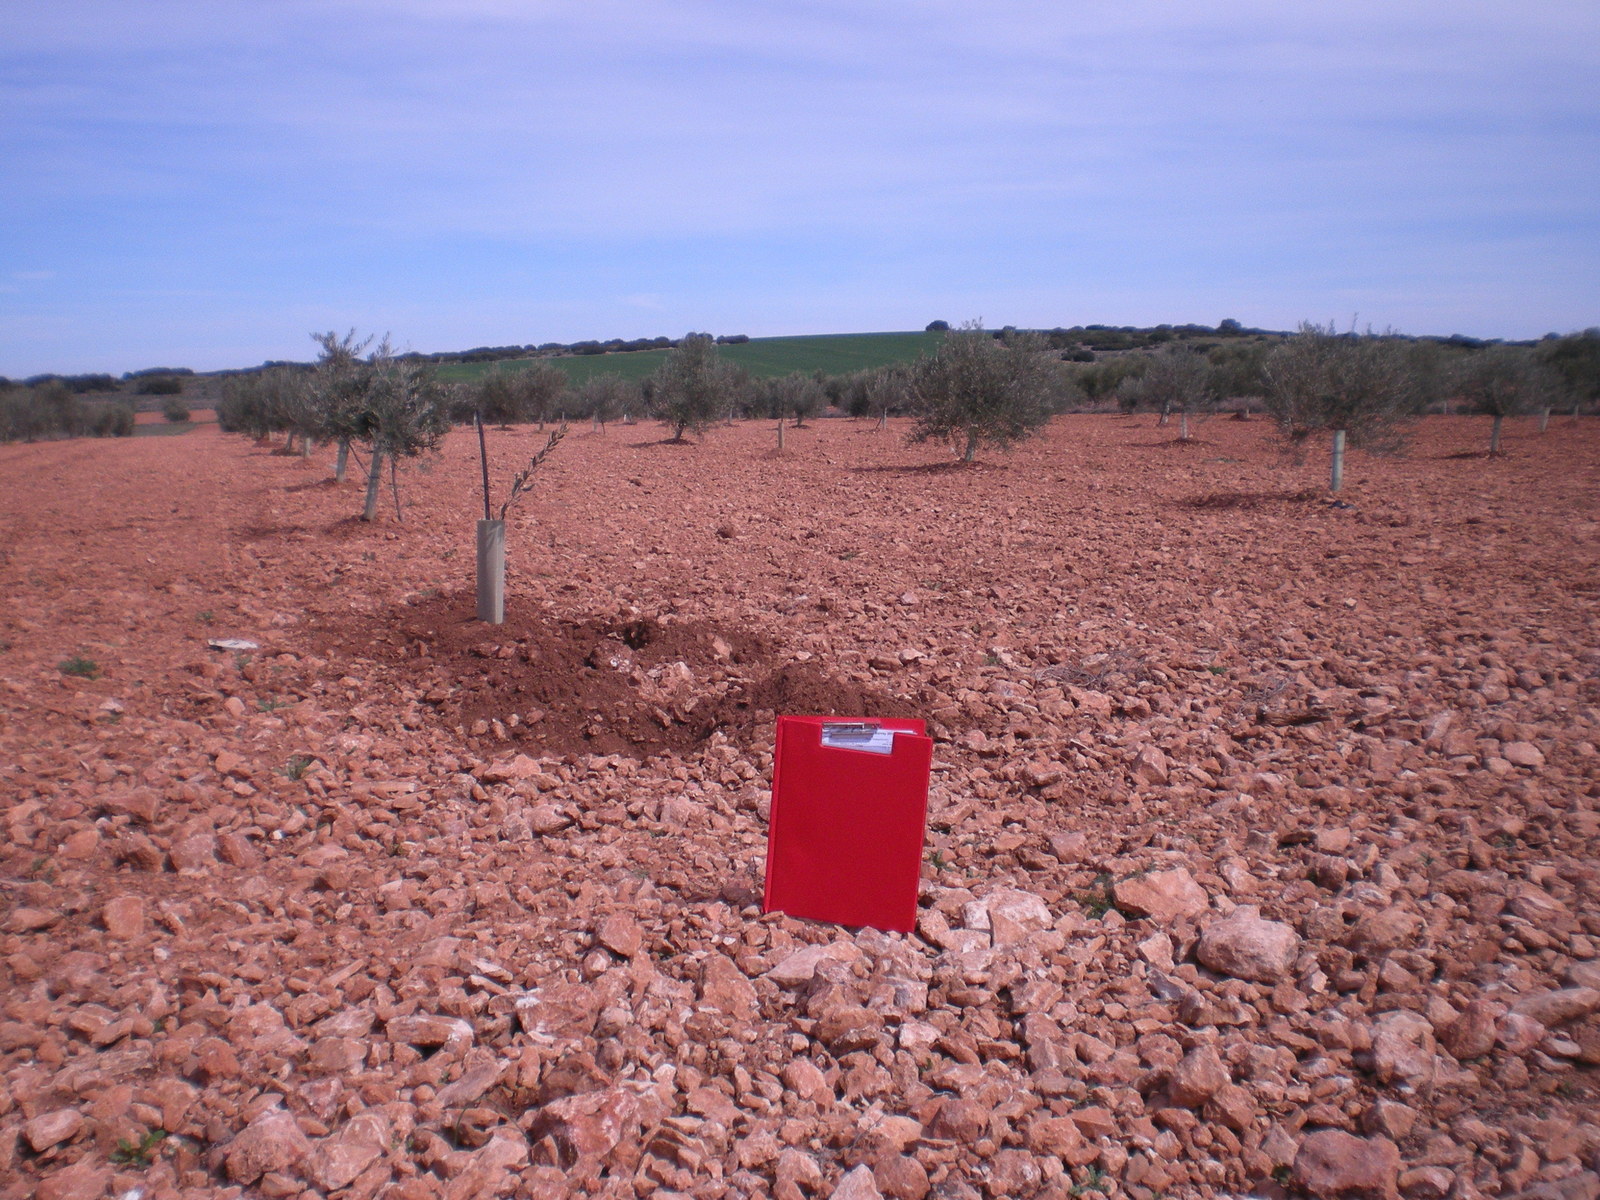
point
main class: Cropland
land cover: Olive groves
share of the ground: < 10 %
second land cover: Other bare soil
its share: > 75 %
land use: Agriculture (excluding fallow land and kitchen gardens)
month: March
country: ES
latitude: 39.0065
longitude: -3.1883
